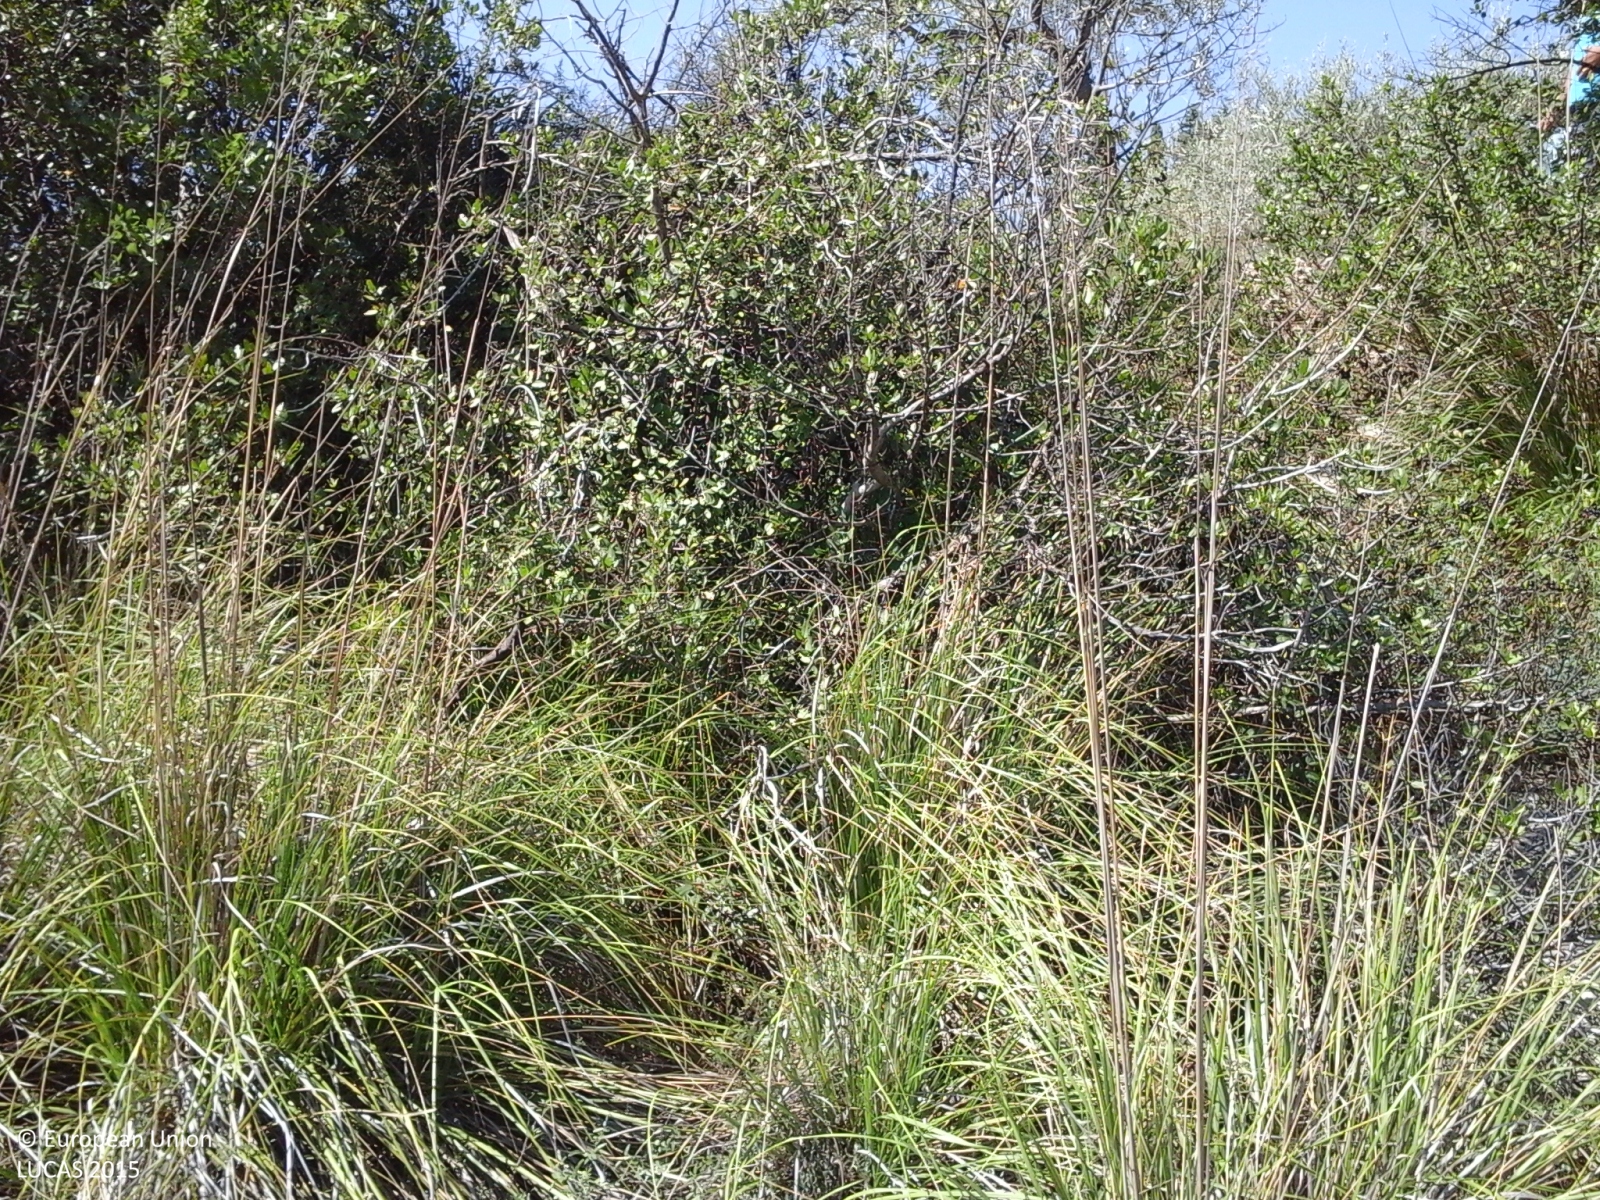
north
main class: Shrubland
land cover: Shrubland with sparse tree cover
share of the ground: > 75 %
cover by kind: shrubs 90 %, coniferous forest trees 5 %, herbaceous plants 5 %
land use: Semi-natural and natural areas not in use
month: July
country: IT
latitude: 37.1492
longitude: 14.8829
